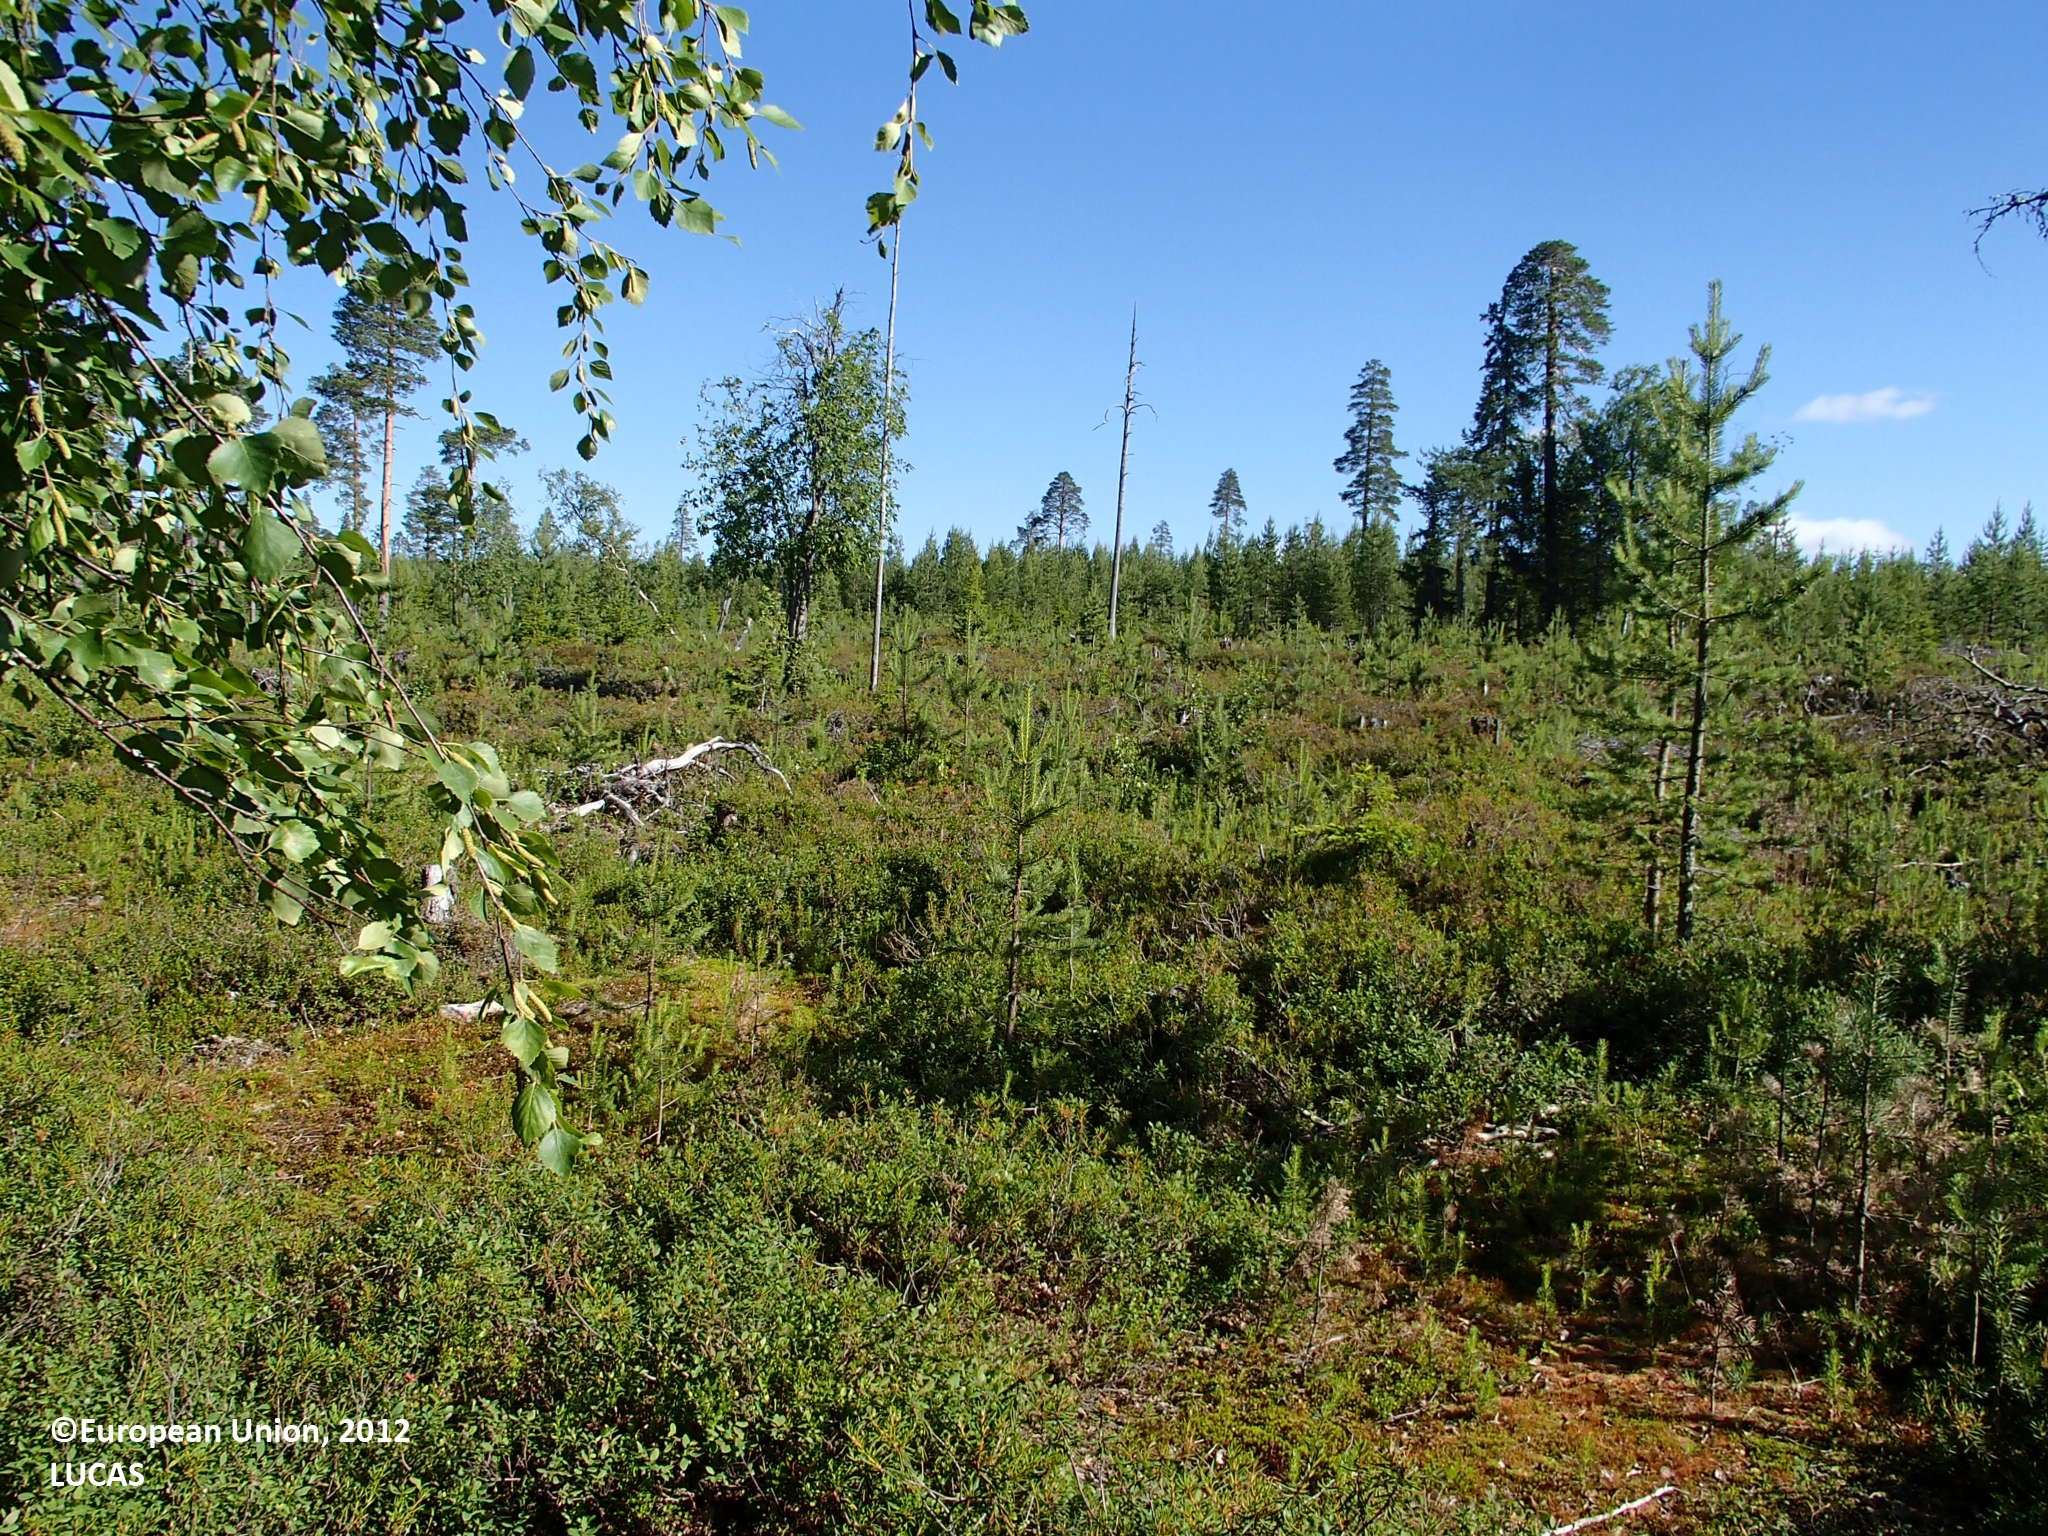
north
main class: Woodland
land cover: Pine dominated coniferous woodland
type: boreal forest
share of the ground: 25 - 50 %
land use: Forestry
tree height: < 5 m
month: July
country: FI
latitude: 66.7930
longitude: 25.7335
